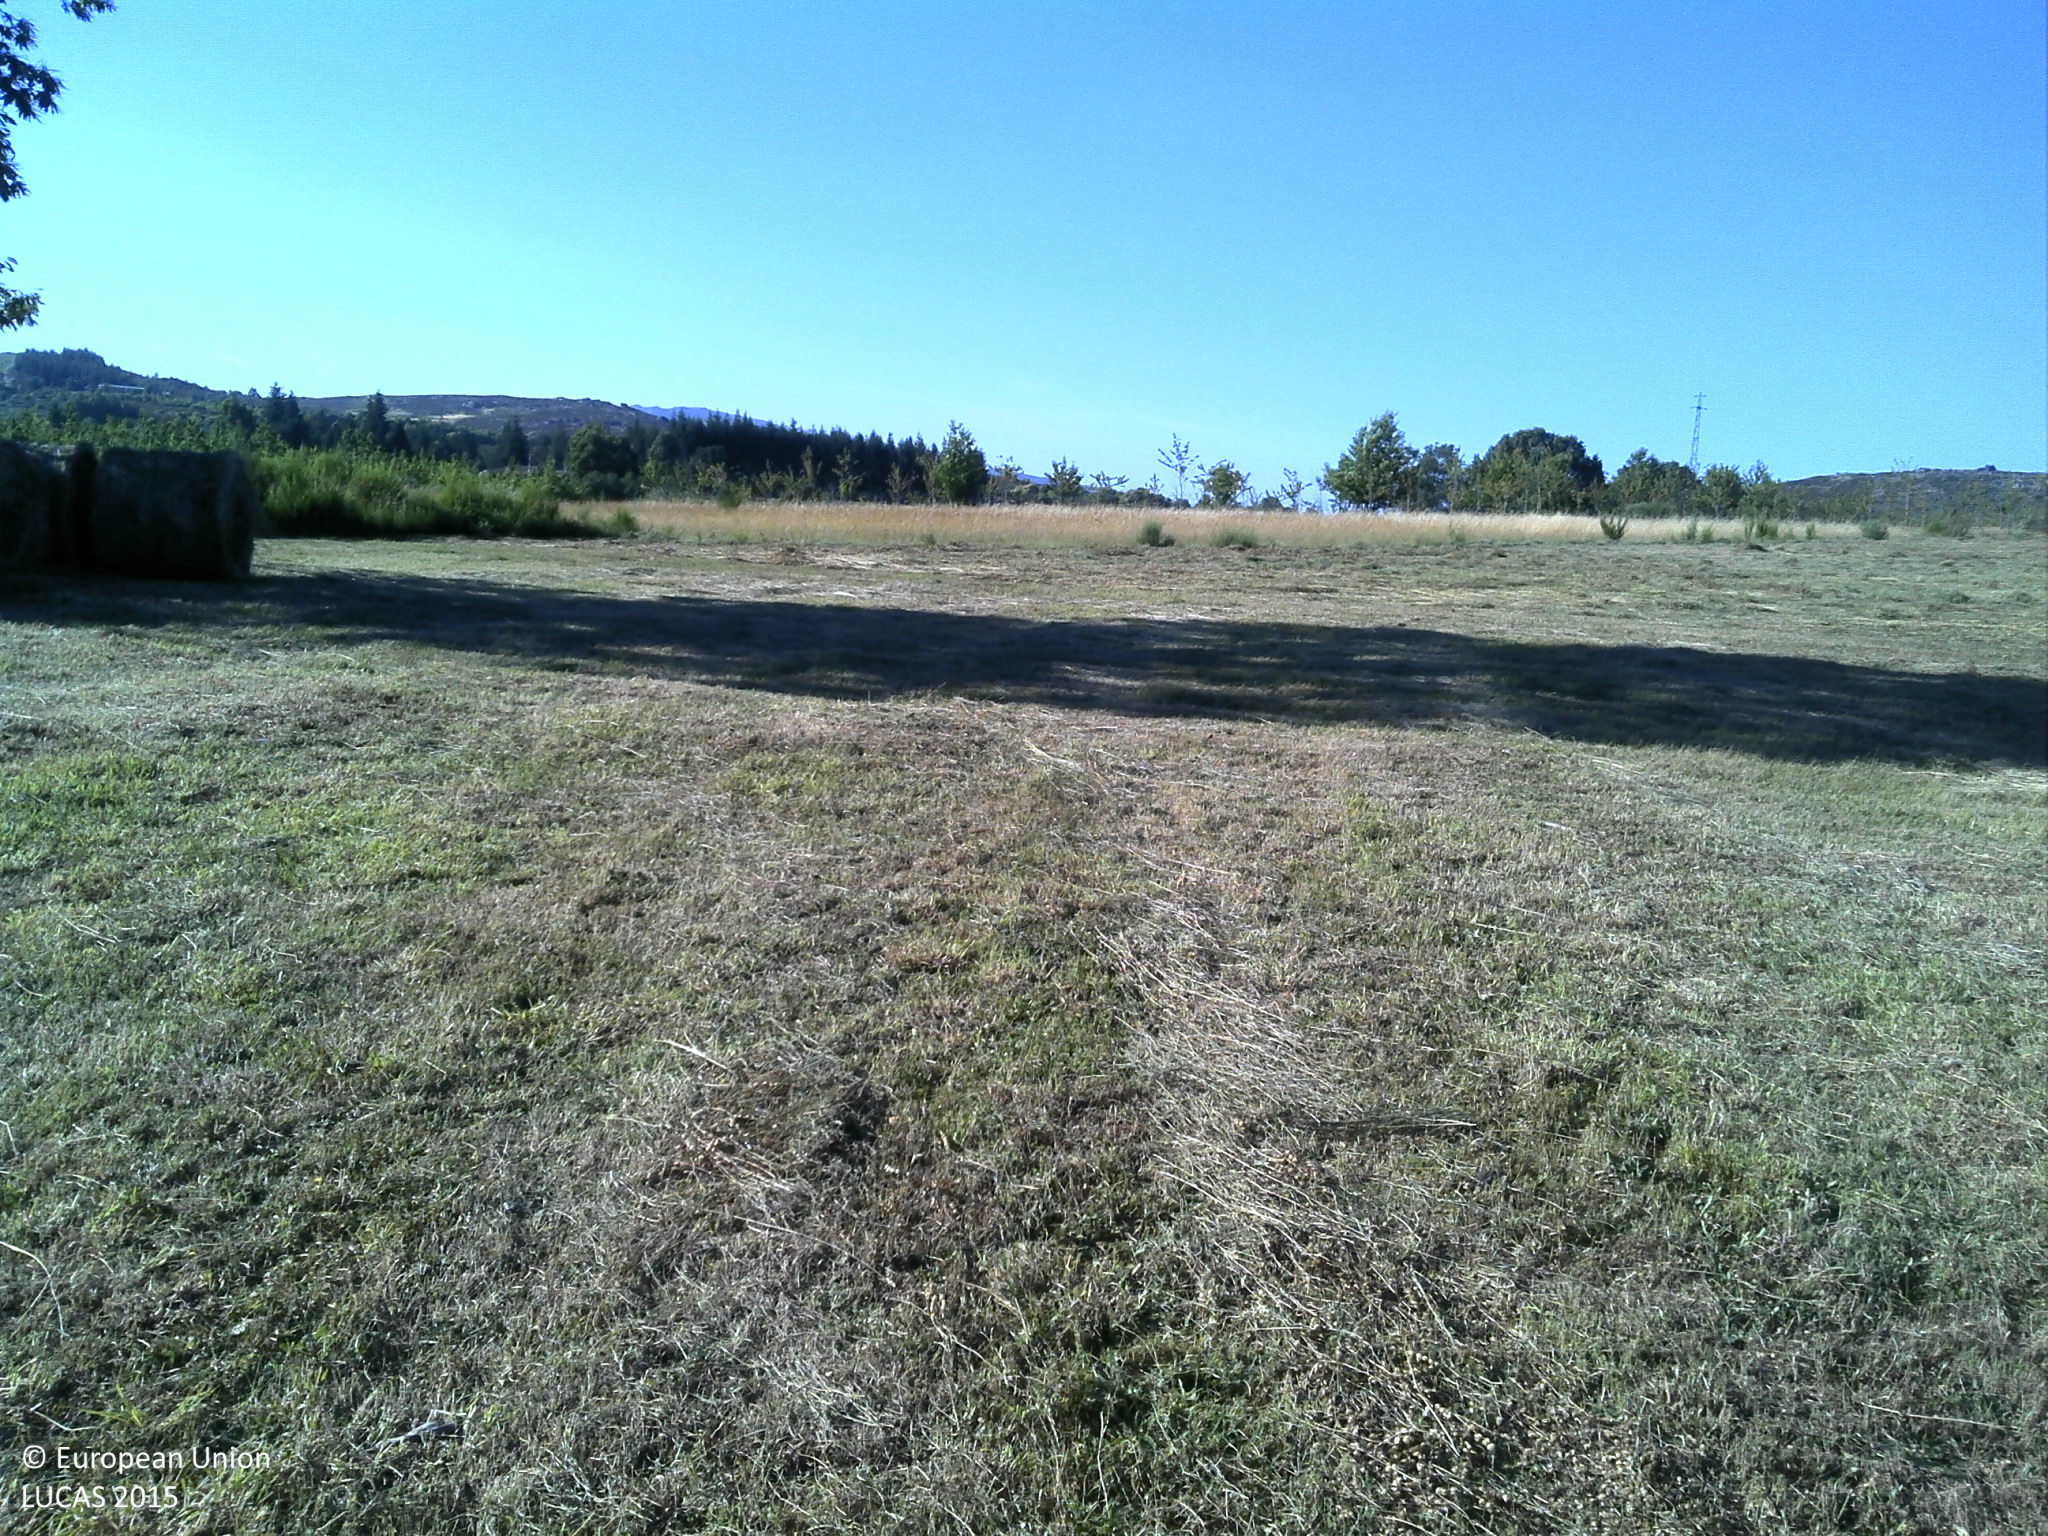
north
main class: Grassland
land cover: Grassland without tree/shrub cover
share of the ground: > 75 %
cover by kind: herbaceous plants 90 %, unconsolidated bare surface 10 %
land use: Agriculture (excluding fallow land and kitchen gardens)
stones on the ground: < 10 %
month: July
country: PT
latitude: 41.8004
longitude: -7.6966
